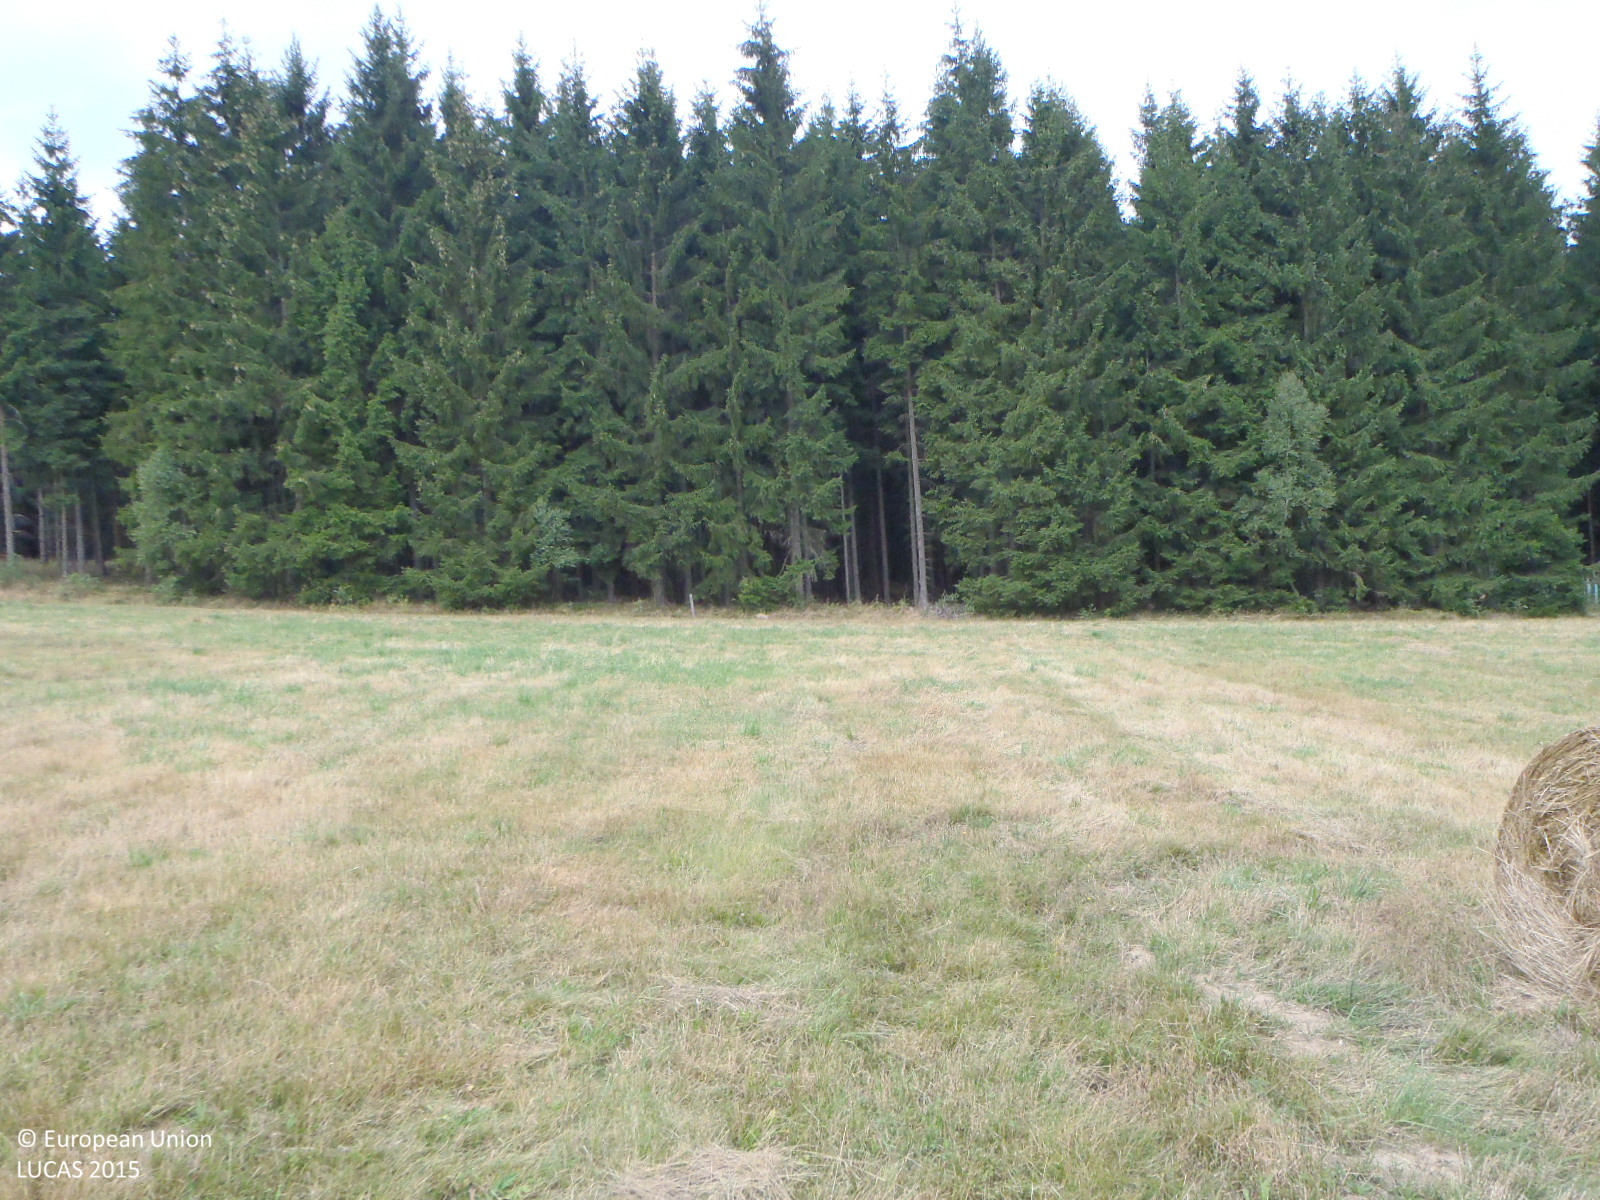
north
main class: Grassland
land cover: Grassland without tree/shrub cover
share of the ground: > 75 %
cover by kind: herbaceous plants 100 %
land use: Agriculture (excluding fallow land and kitchen gardens)
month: August
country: CZ
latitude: 50.8079
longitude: 14.6995
